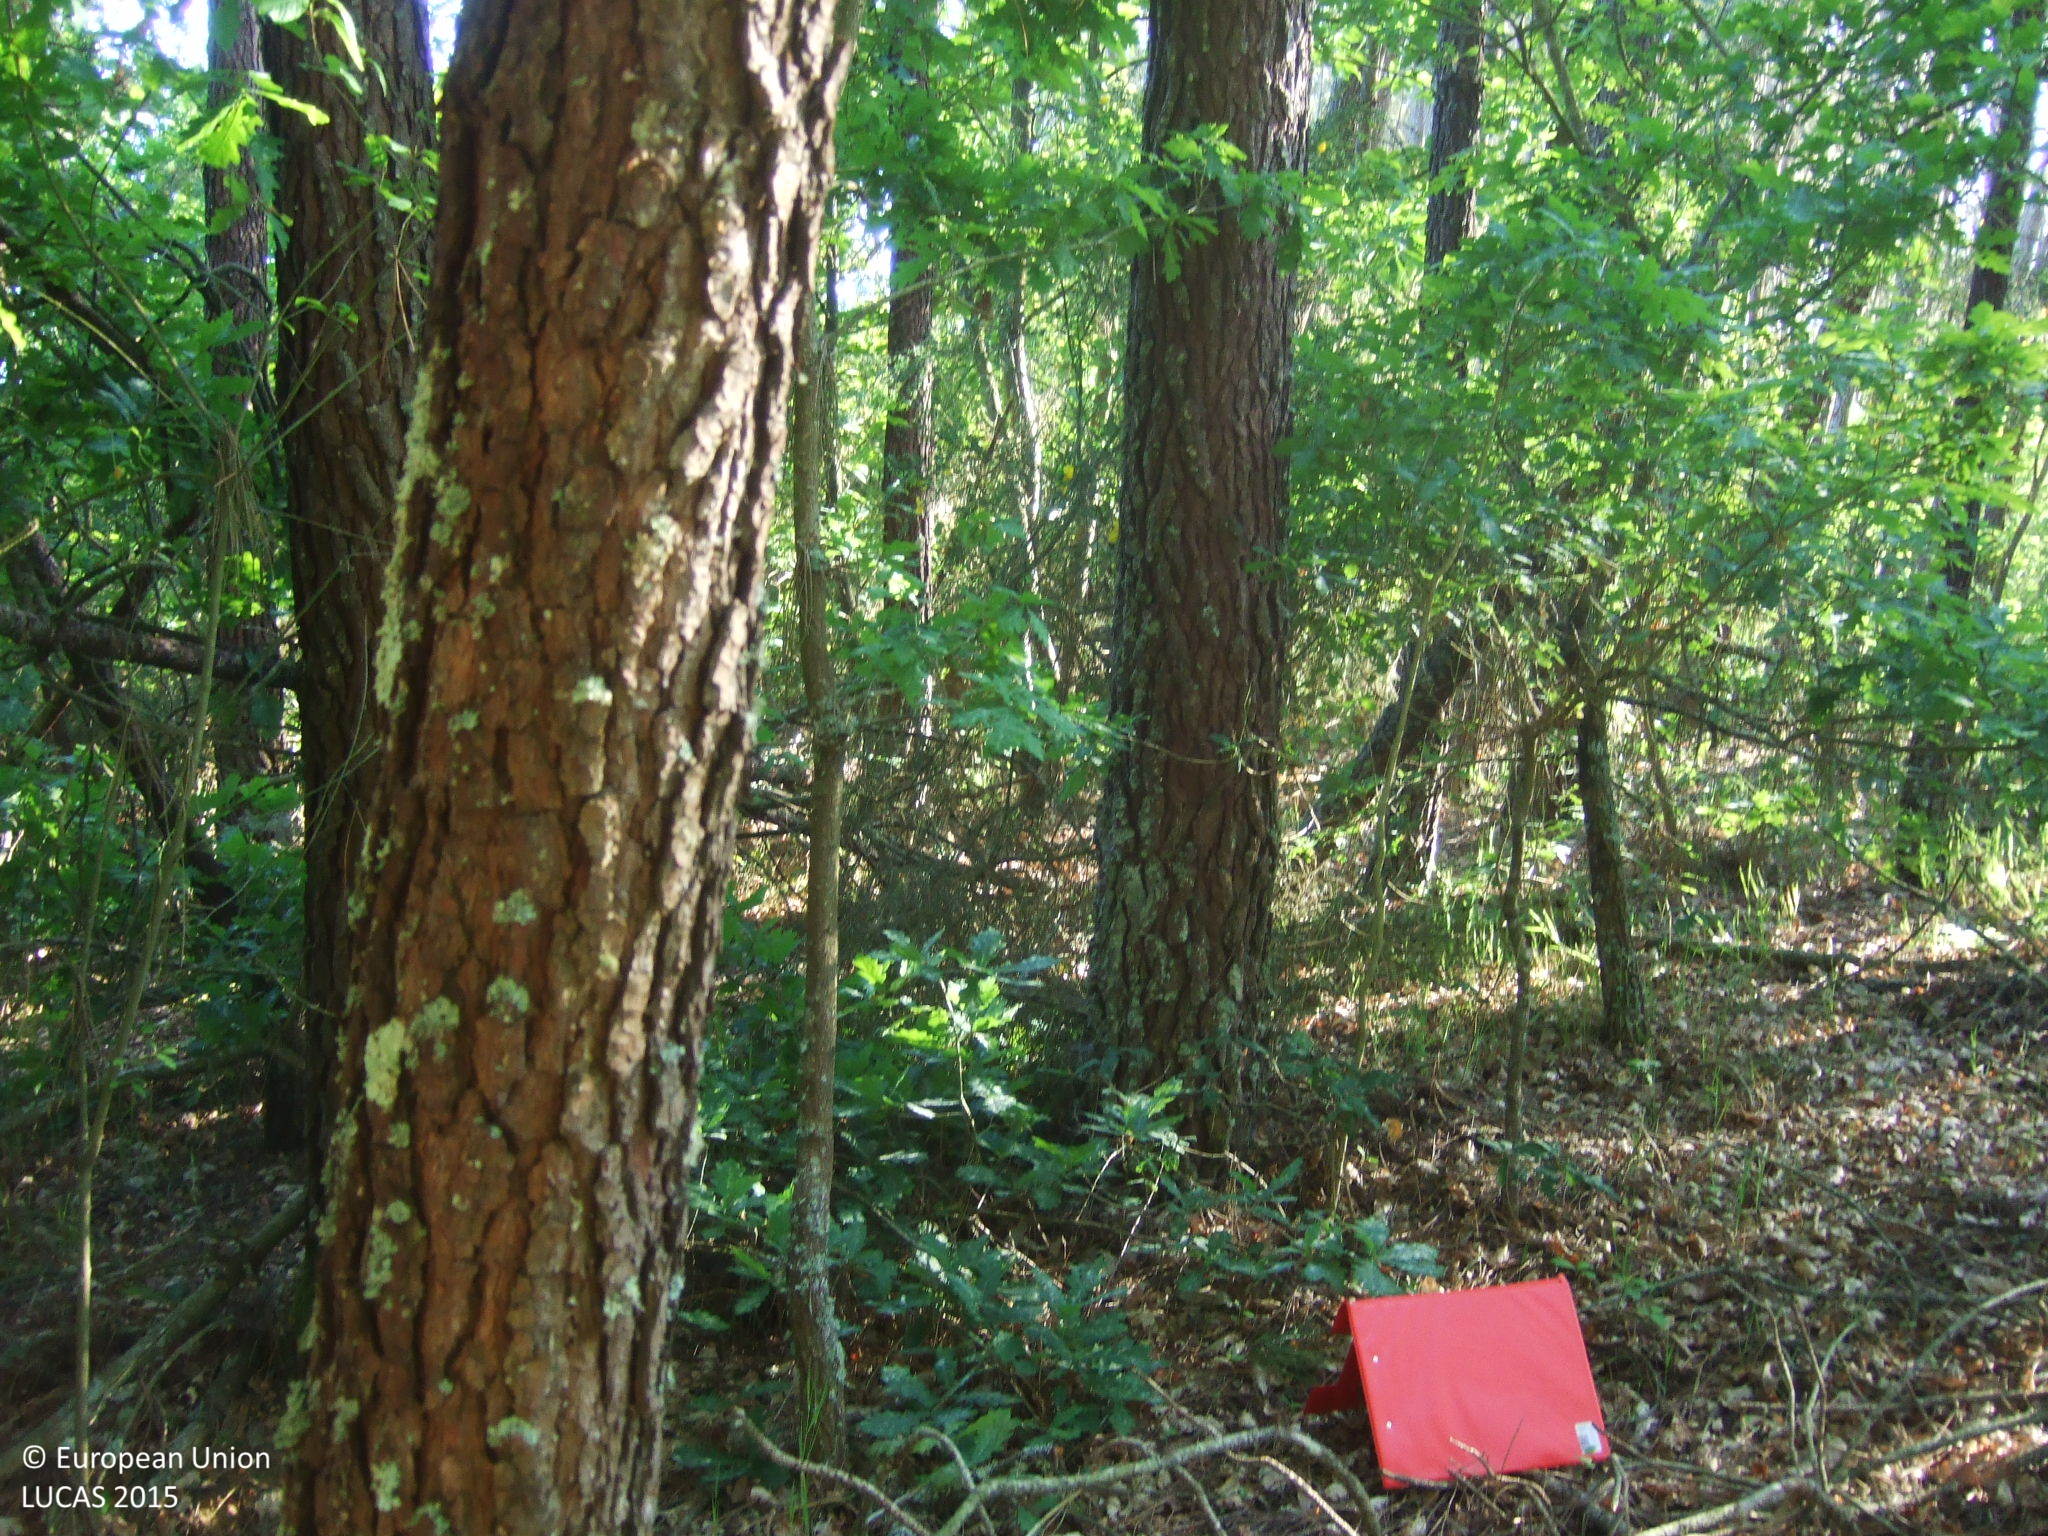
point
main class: Woodland
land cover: Pine dominated coniferous woodland
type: exotic forest
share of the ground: 50 - 75 %
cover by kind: coniferous forest trees 65 %, unconsolidated bare surface 20 %, shrubs 10 %, broadleaved forest trees 5 %
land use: Forestry
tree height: > 5 m
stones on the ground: < 10 %
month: May
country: ES
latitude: 42.7339
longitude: -7.5269
